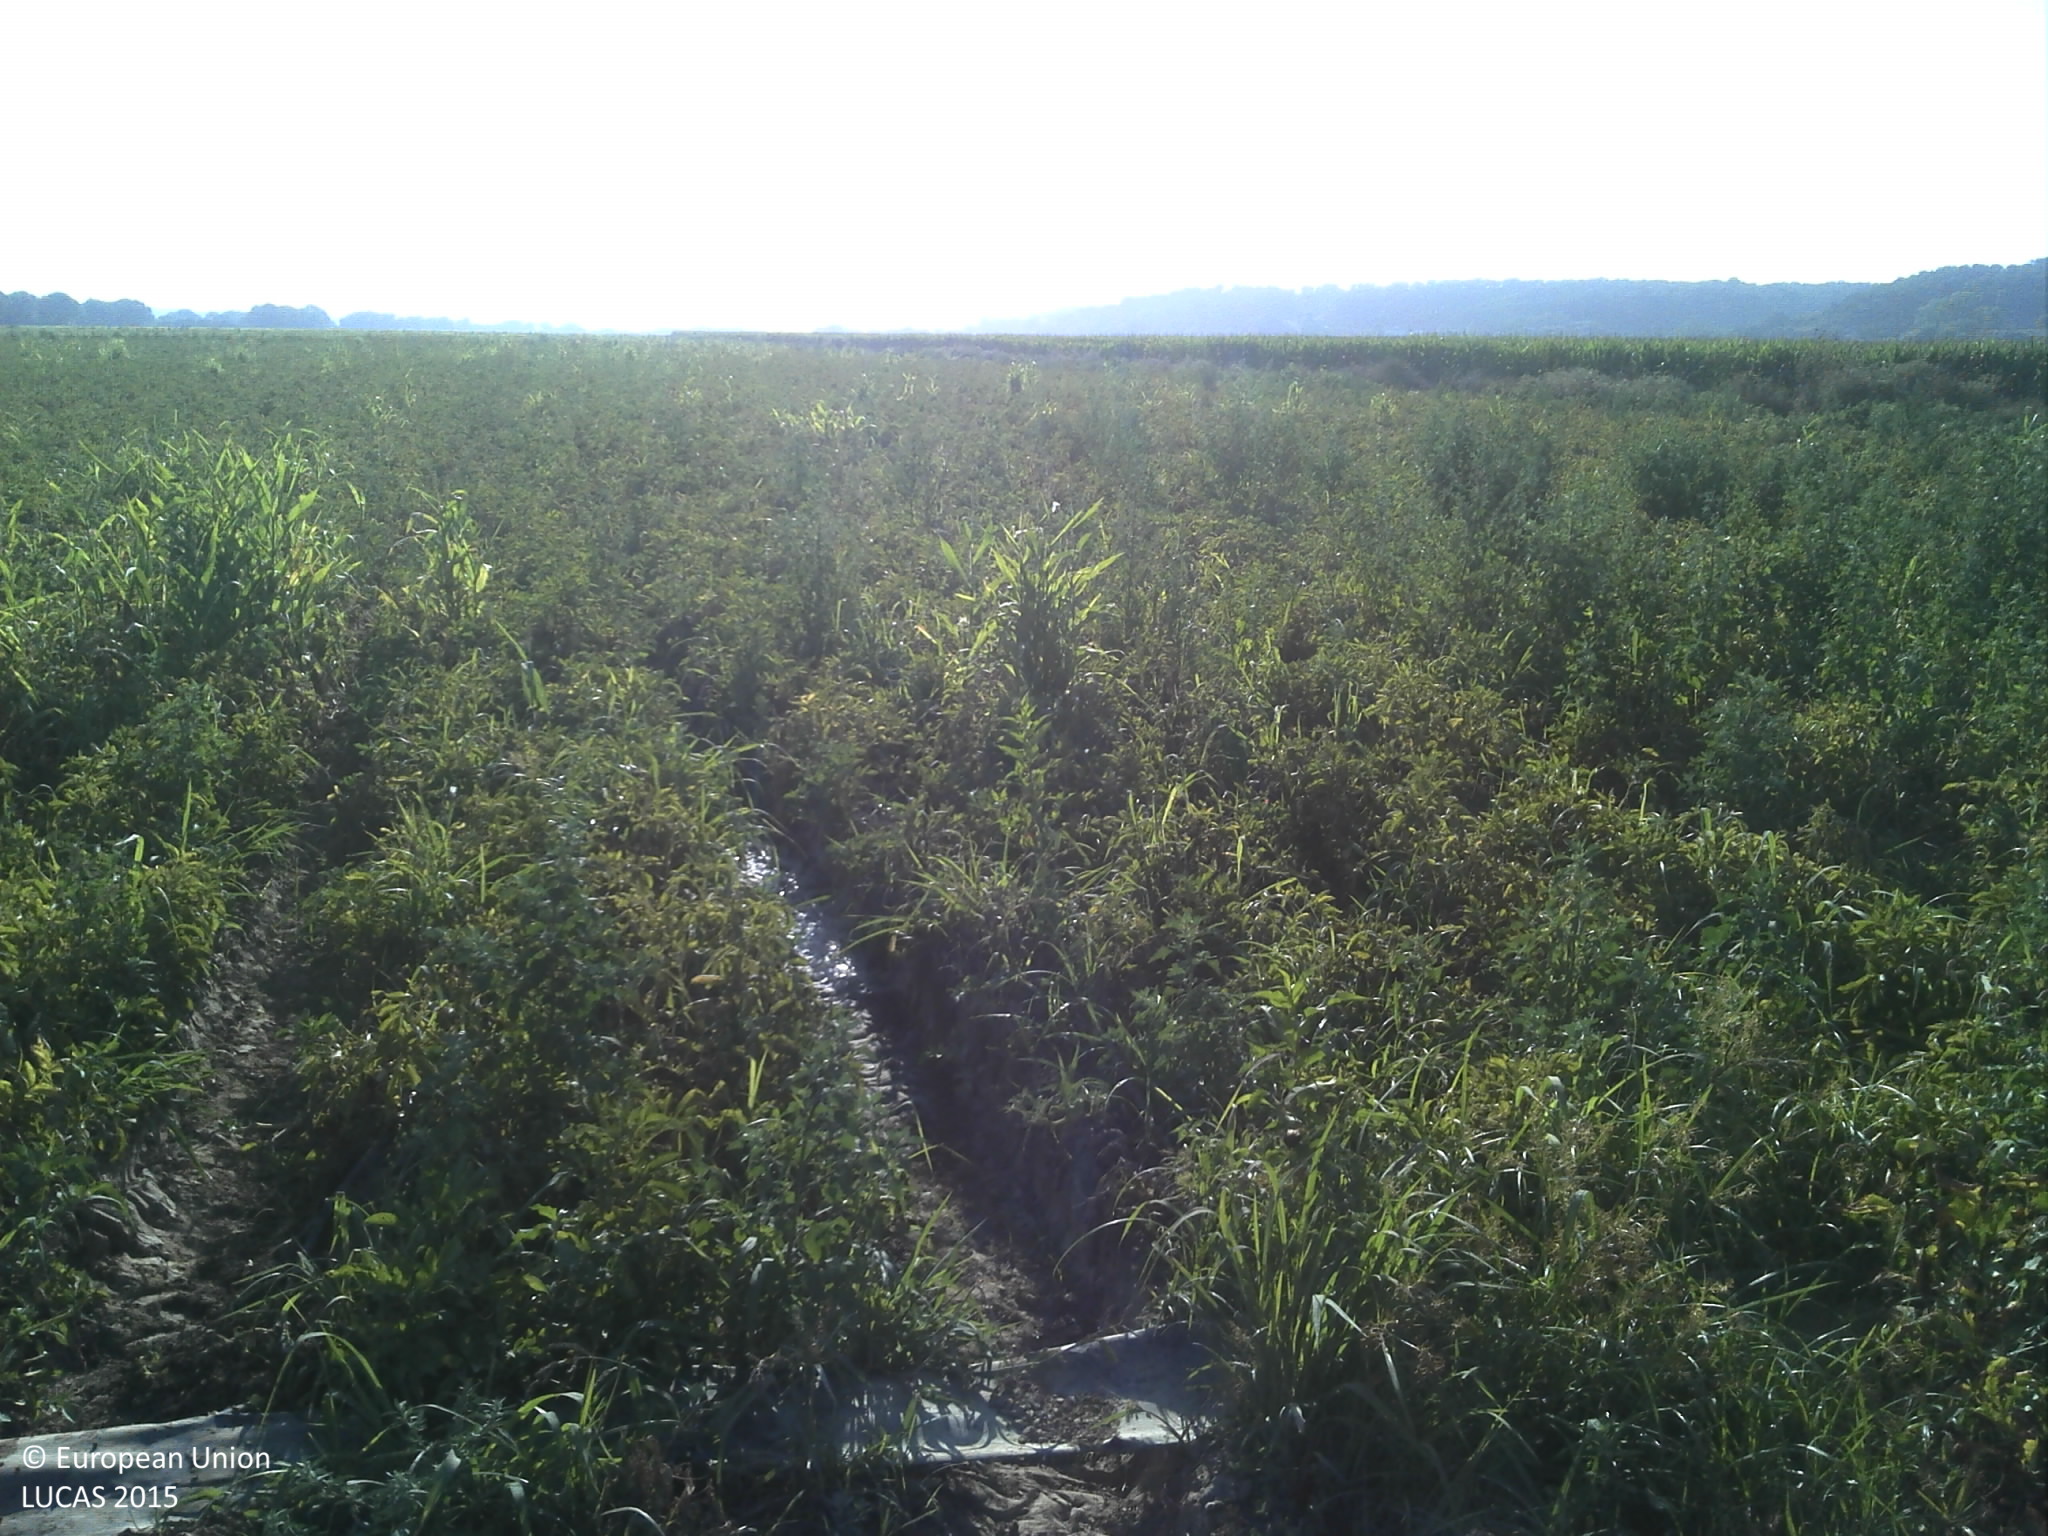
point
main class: Cropland
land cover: Potatoes
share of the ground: > 75 %
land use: Agriculture (excluding fallow land and kitchen gardens)
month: July
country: PT
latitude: 38.9376
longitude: -8.5800
